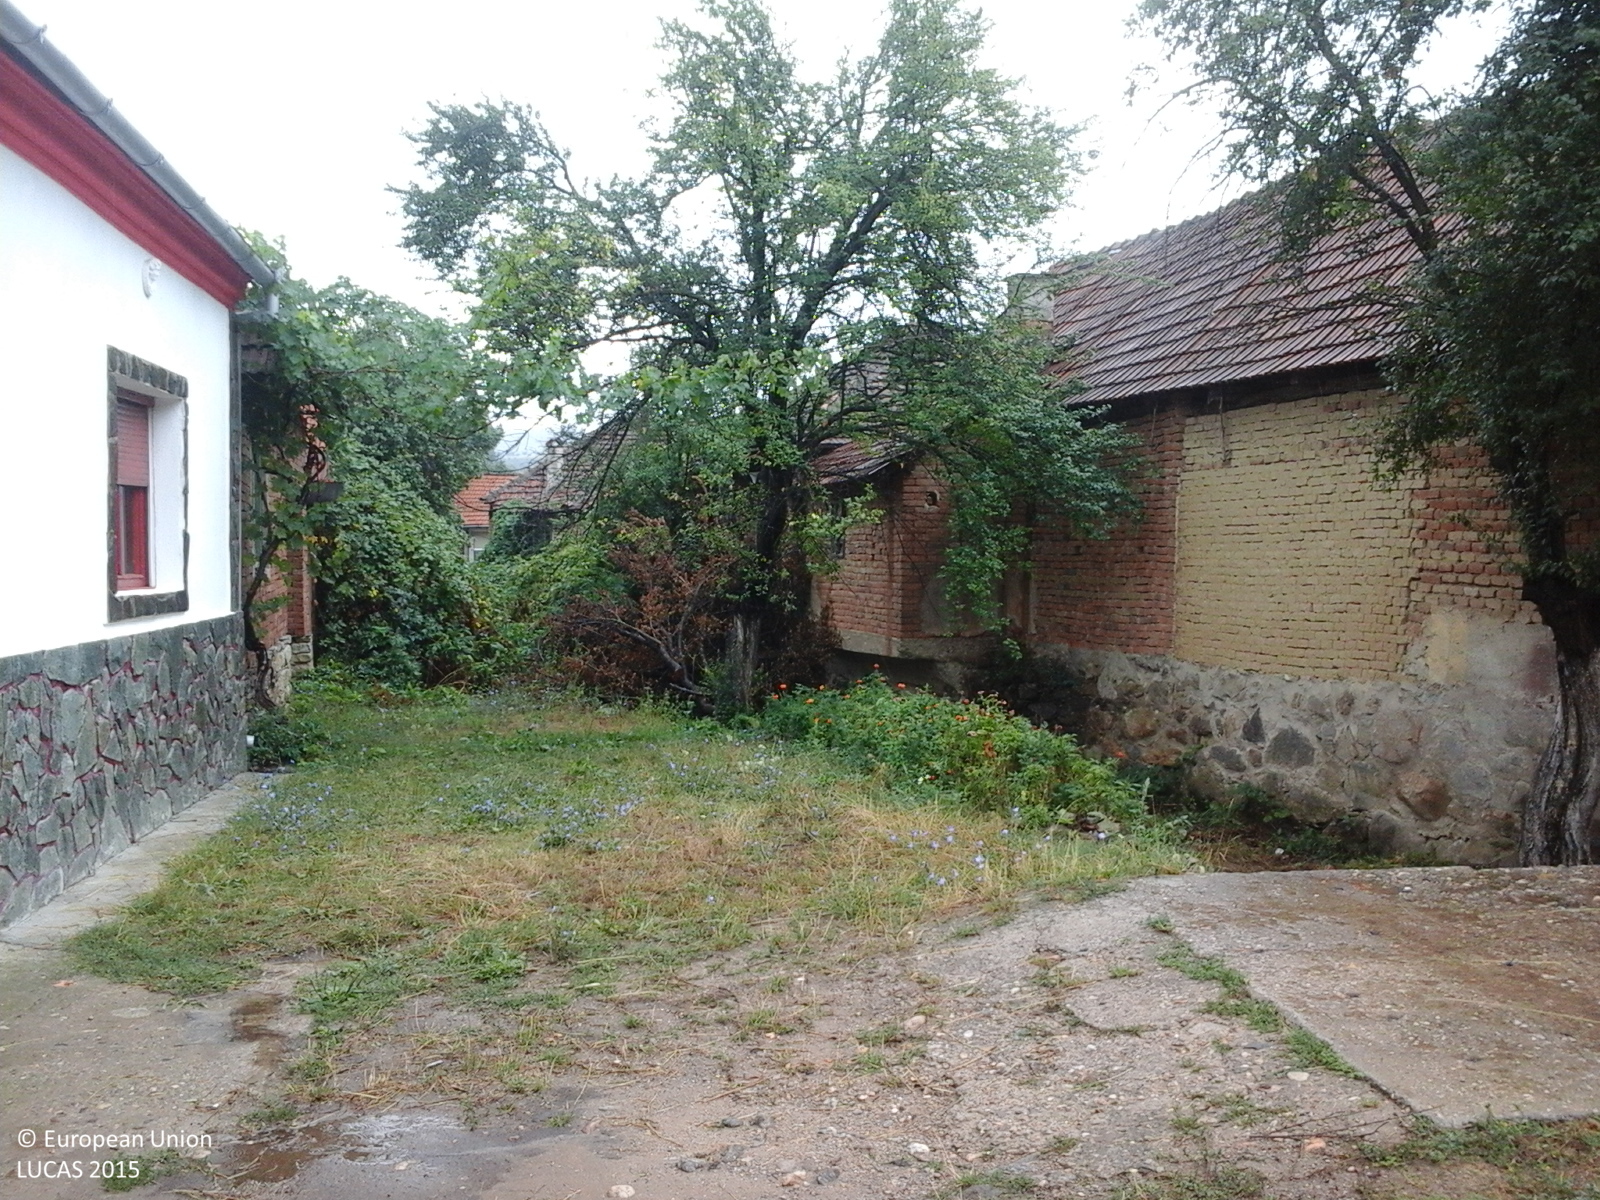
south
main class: Grassland
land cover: Grassland without tree/shrub cover
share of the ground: > 75 %
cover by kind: herbaceous plants 100 %
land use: Residential
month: August
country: RO
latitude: 45.0414
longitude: 22.2643
